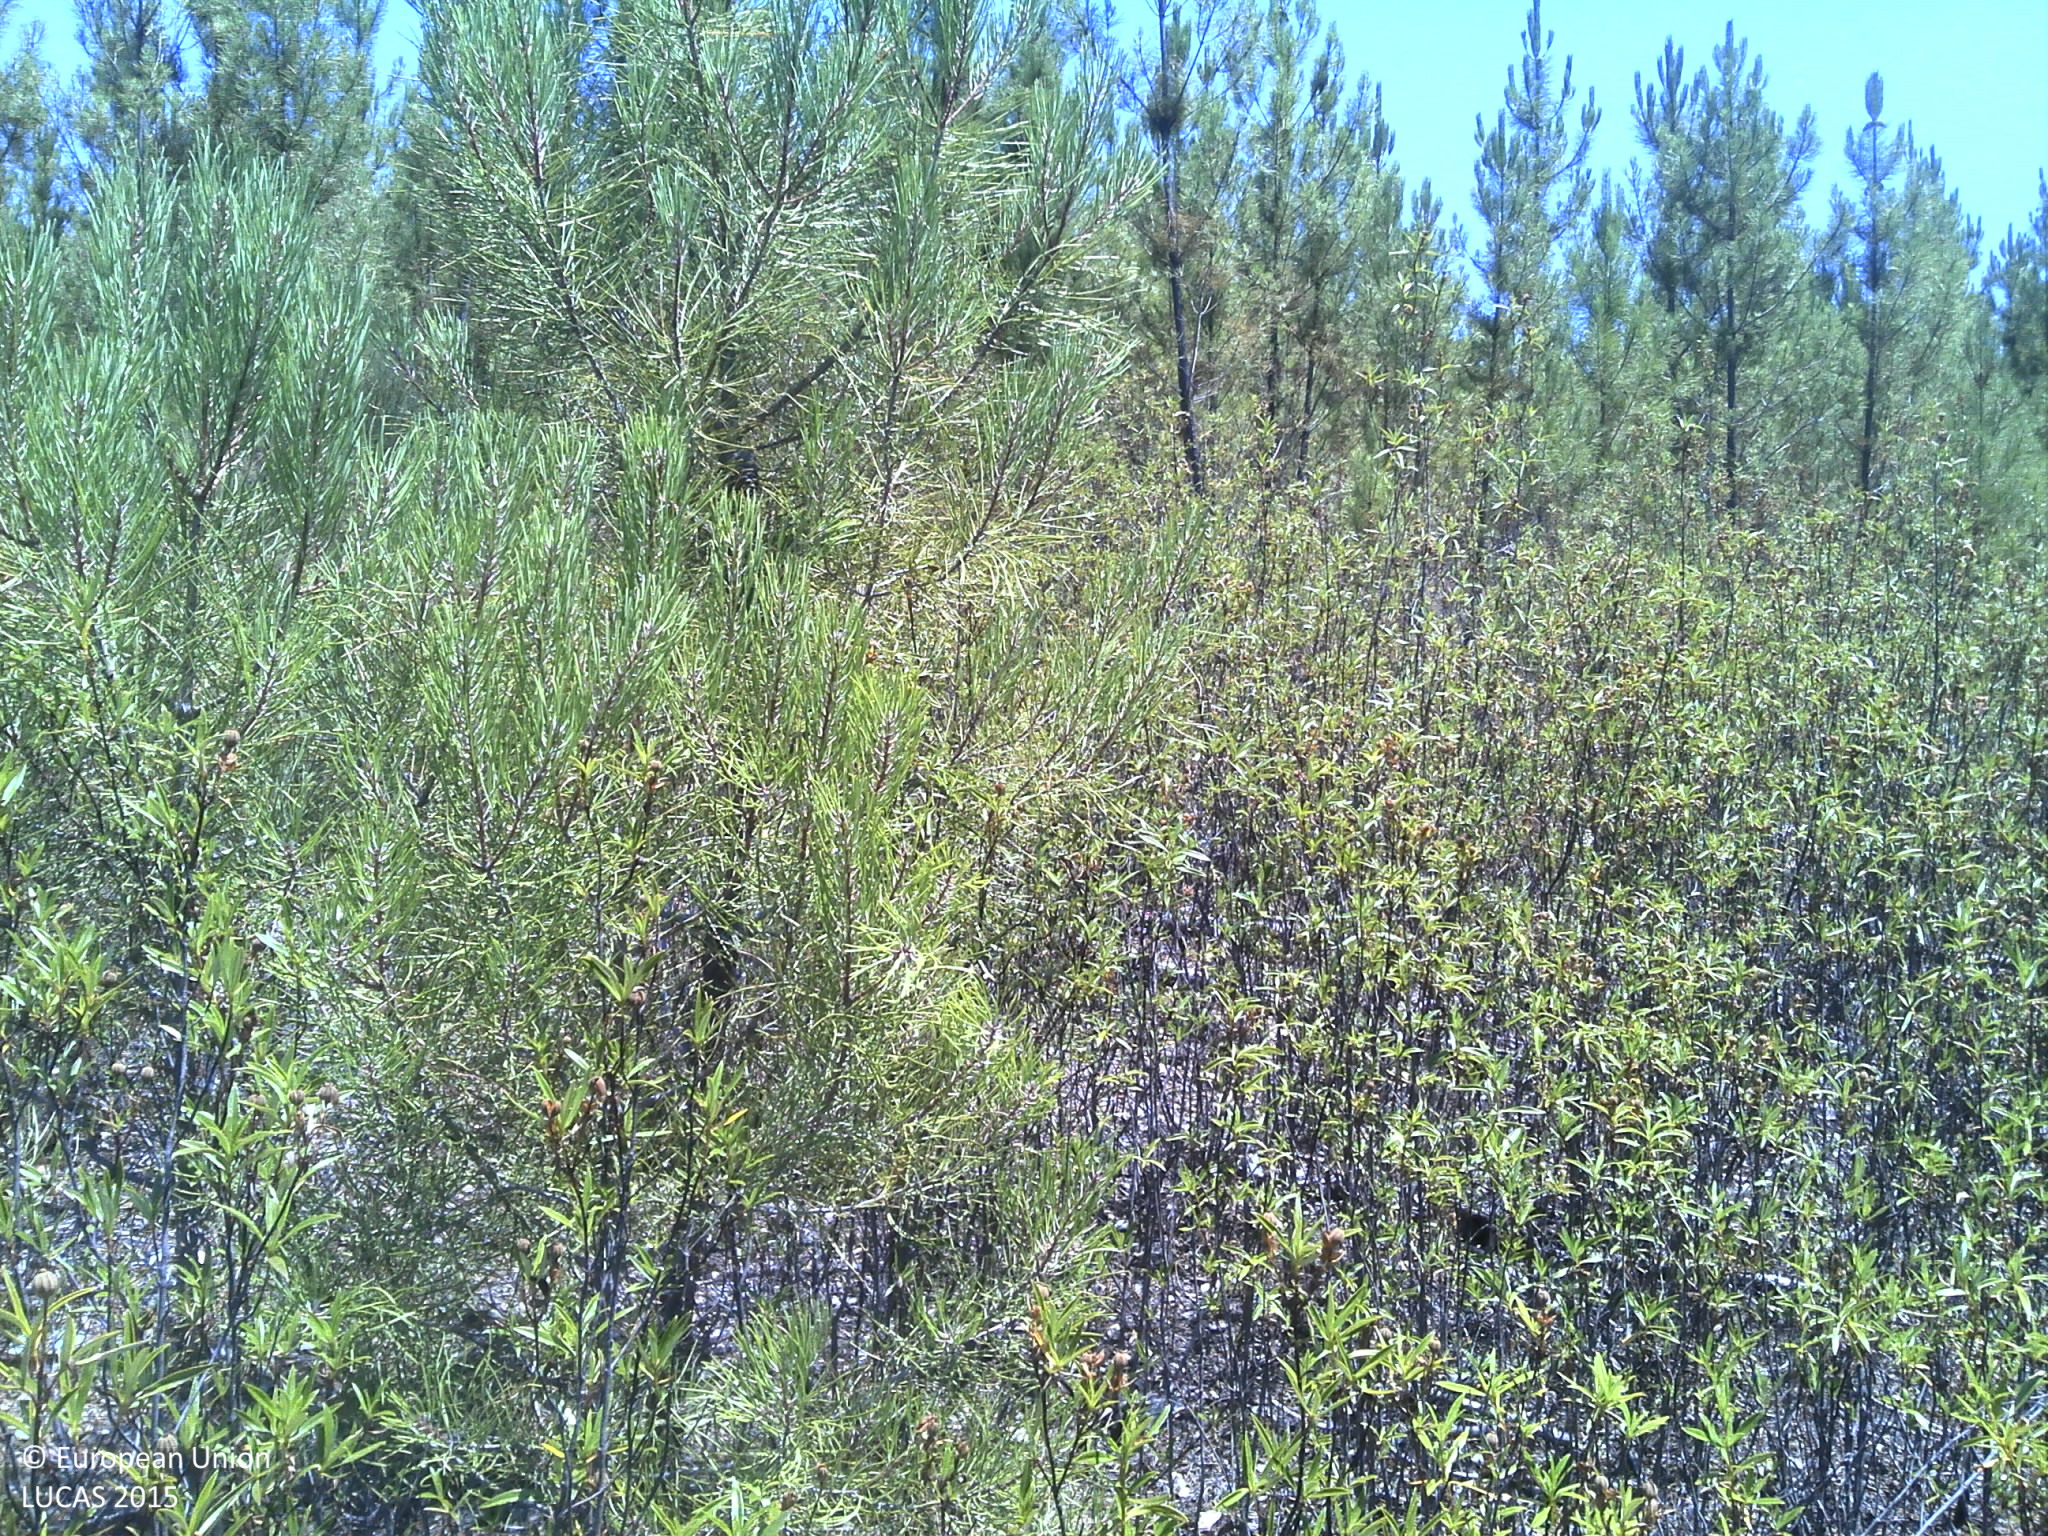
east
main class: Woodland
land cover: Pine dominated coniferous woodland
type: coniferous forest of the mediterranean region
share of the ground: 10 - 25 %
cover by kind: shrubs 75 %, coniferous forest trees 15 %, unconsolidated bare surface 10 %
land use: Forestry
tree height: < 5 m
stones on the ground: 10 - 25 %
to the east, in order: Pine dominated coniferous woodland; Shrubland with sparse tree cover; Pine dominated coniferous woodland; Tracks; Pine dominated coniferous woodland; Shrubland with sparse tree cover; Rivers and streams; Shrubland with sparse tree cover; Pine dominated coniferous woodland
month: July
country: PT
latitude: 39.9413
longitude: -7.6722
